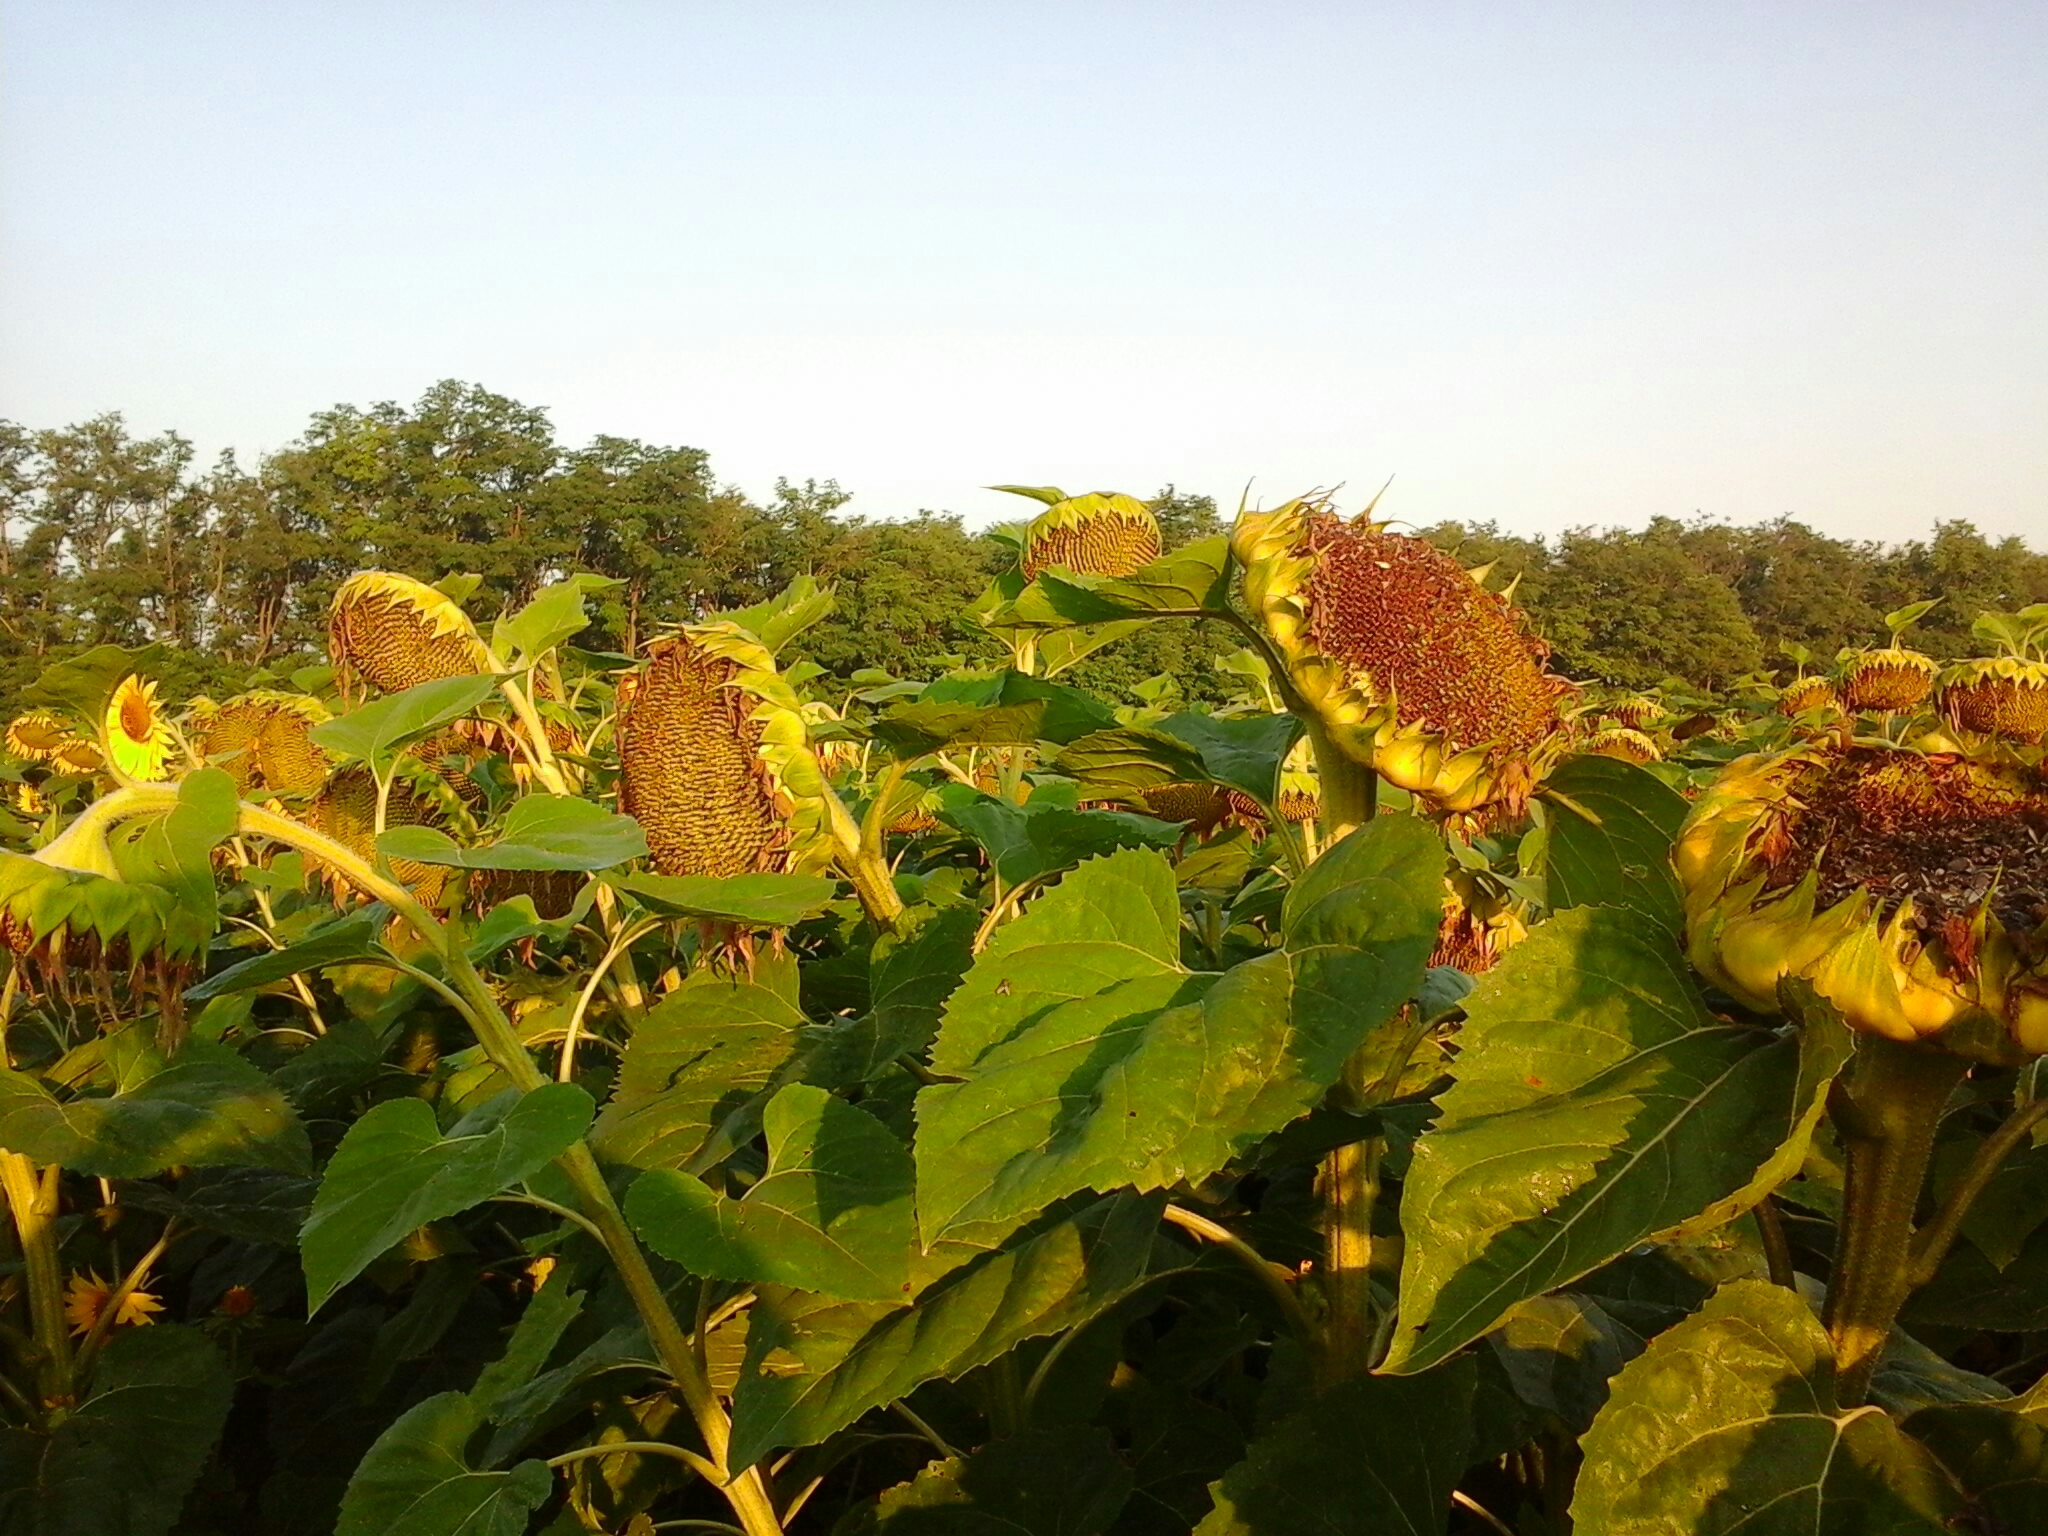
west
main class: Cropland
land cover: Sunflower
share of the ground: > 75 %
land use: Agriculture (excluding fallow land and kitchen gardens)
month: August
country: HU
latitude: 47.6384
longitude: 18.0642
